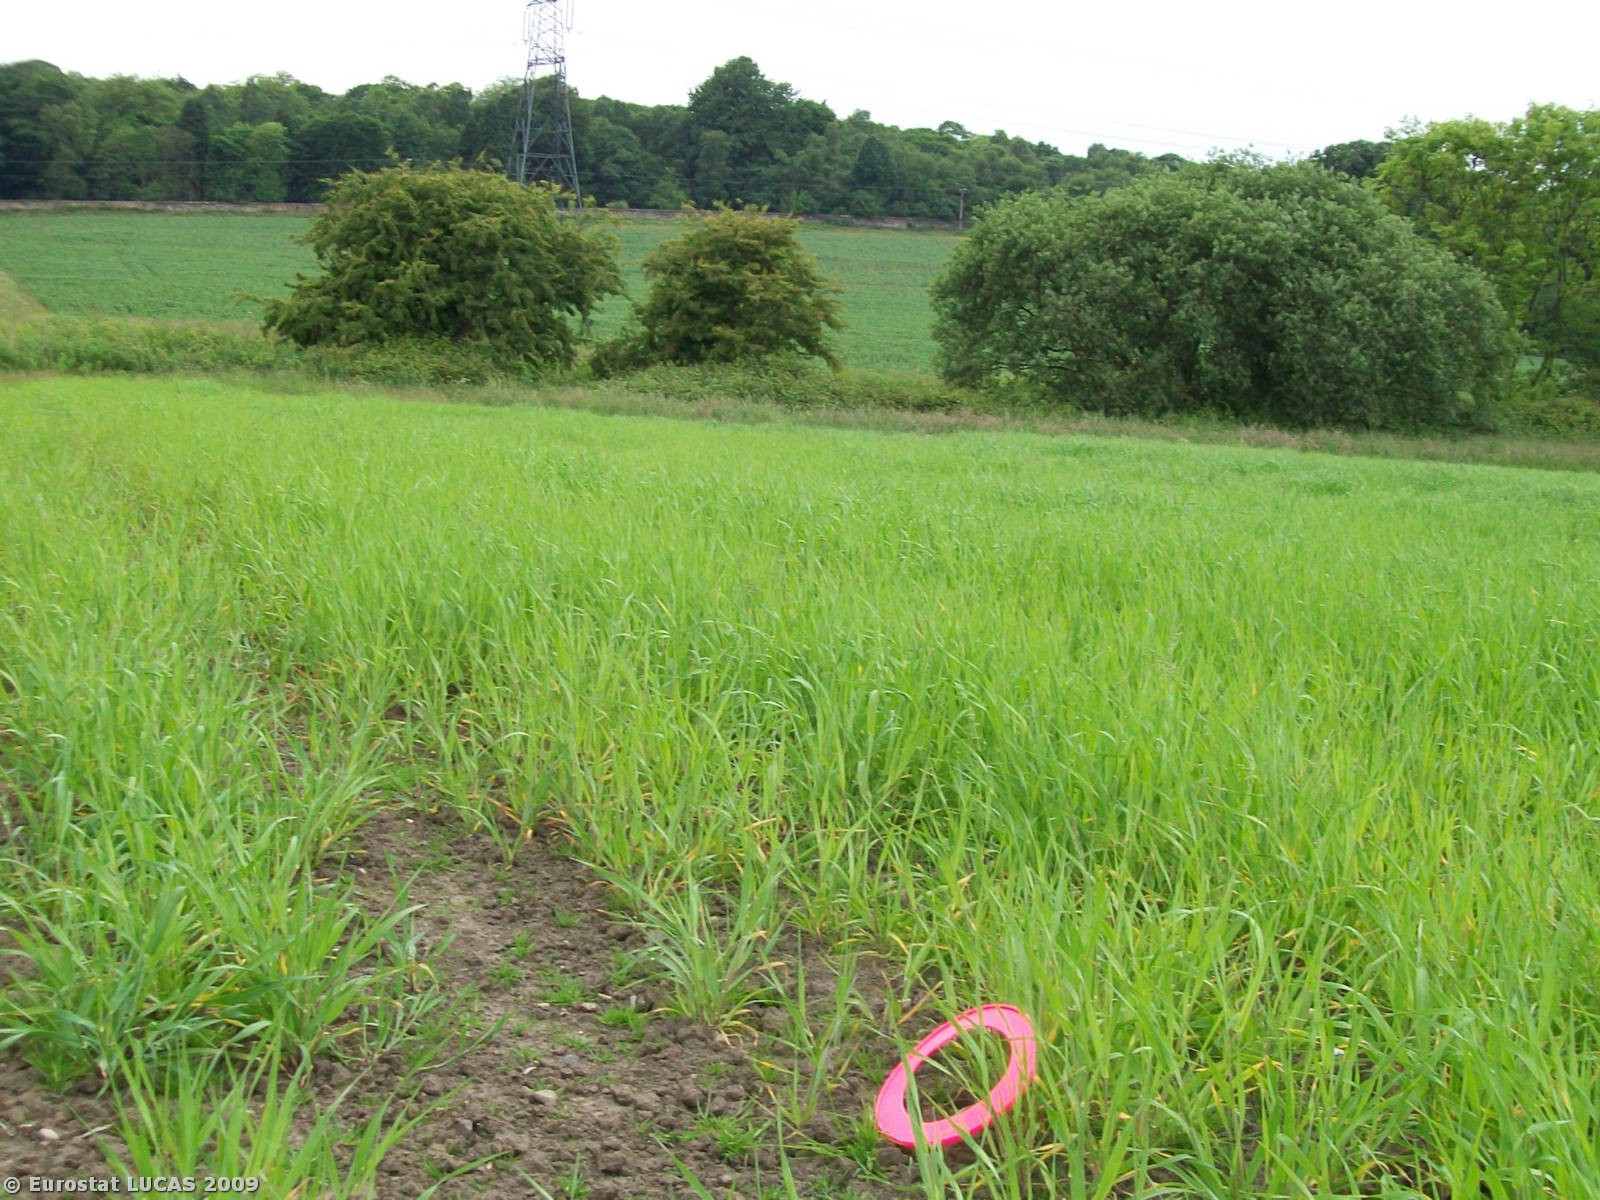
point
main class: Cropland
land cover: Barley
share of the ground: < 10 %
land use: Agriculture (excluding fallow land and kitchen gardens)
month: June
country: GB
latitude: 53.4483
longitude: -2.7938
